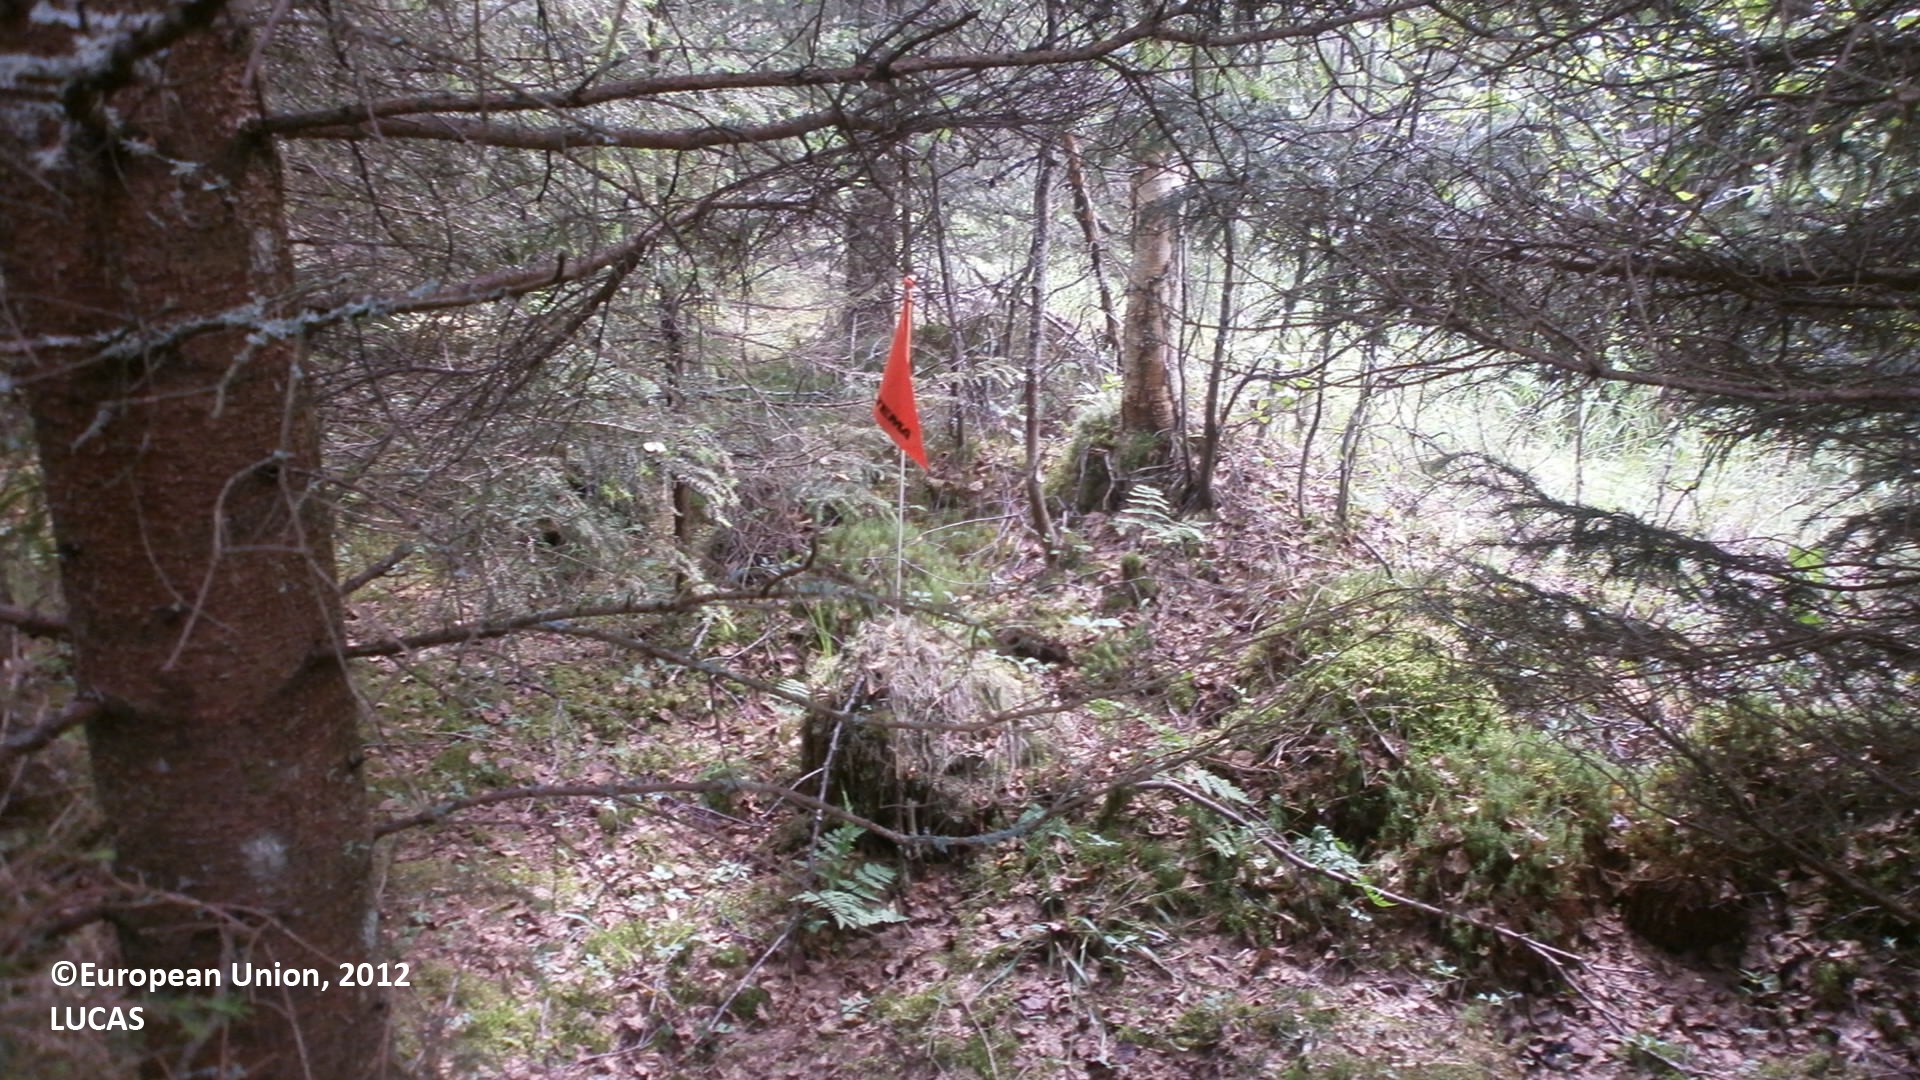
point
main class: Woodland
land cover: Spruce dominated coniferous woodland
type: boreal forest
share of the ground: > 75 %
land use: Forestry
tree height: > 5 m
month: July
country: FI
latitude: 64.2342
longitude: 24.4001
